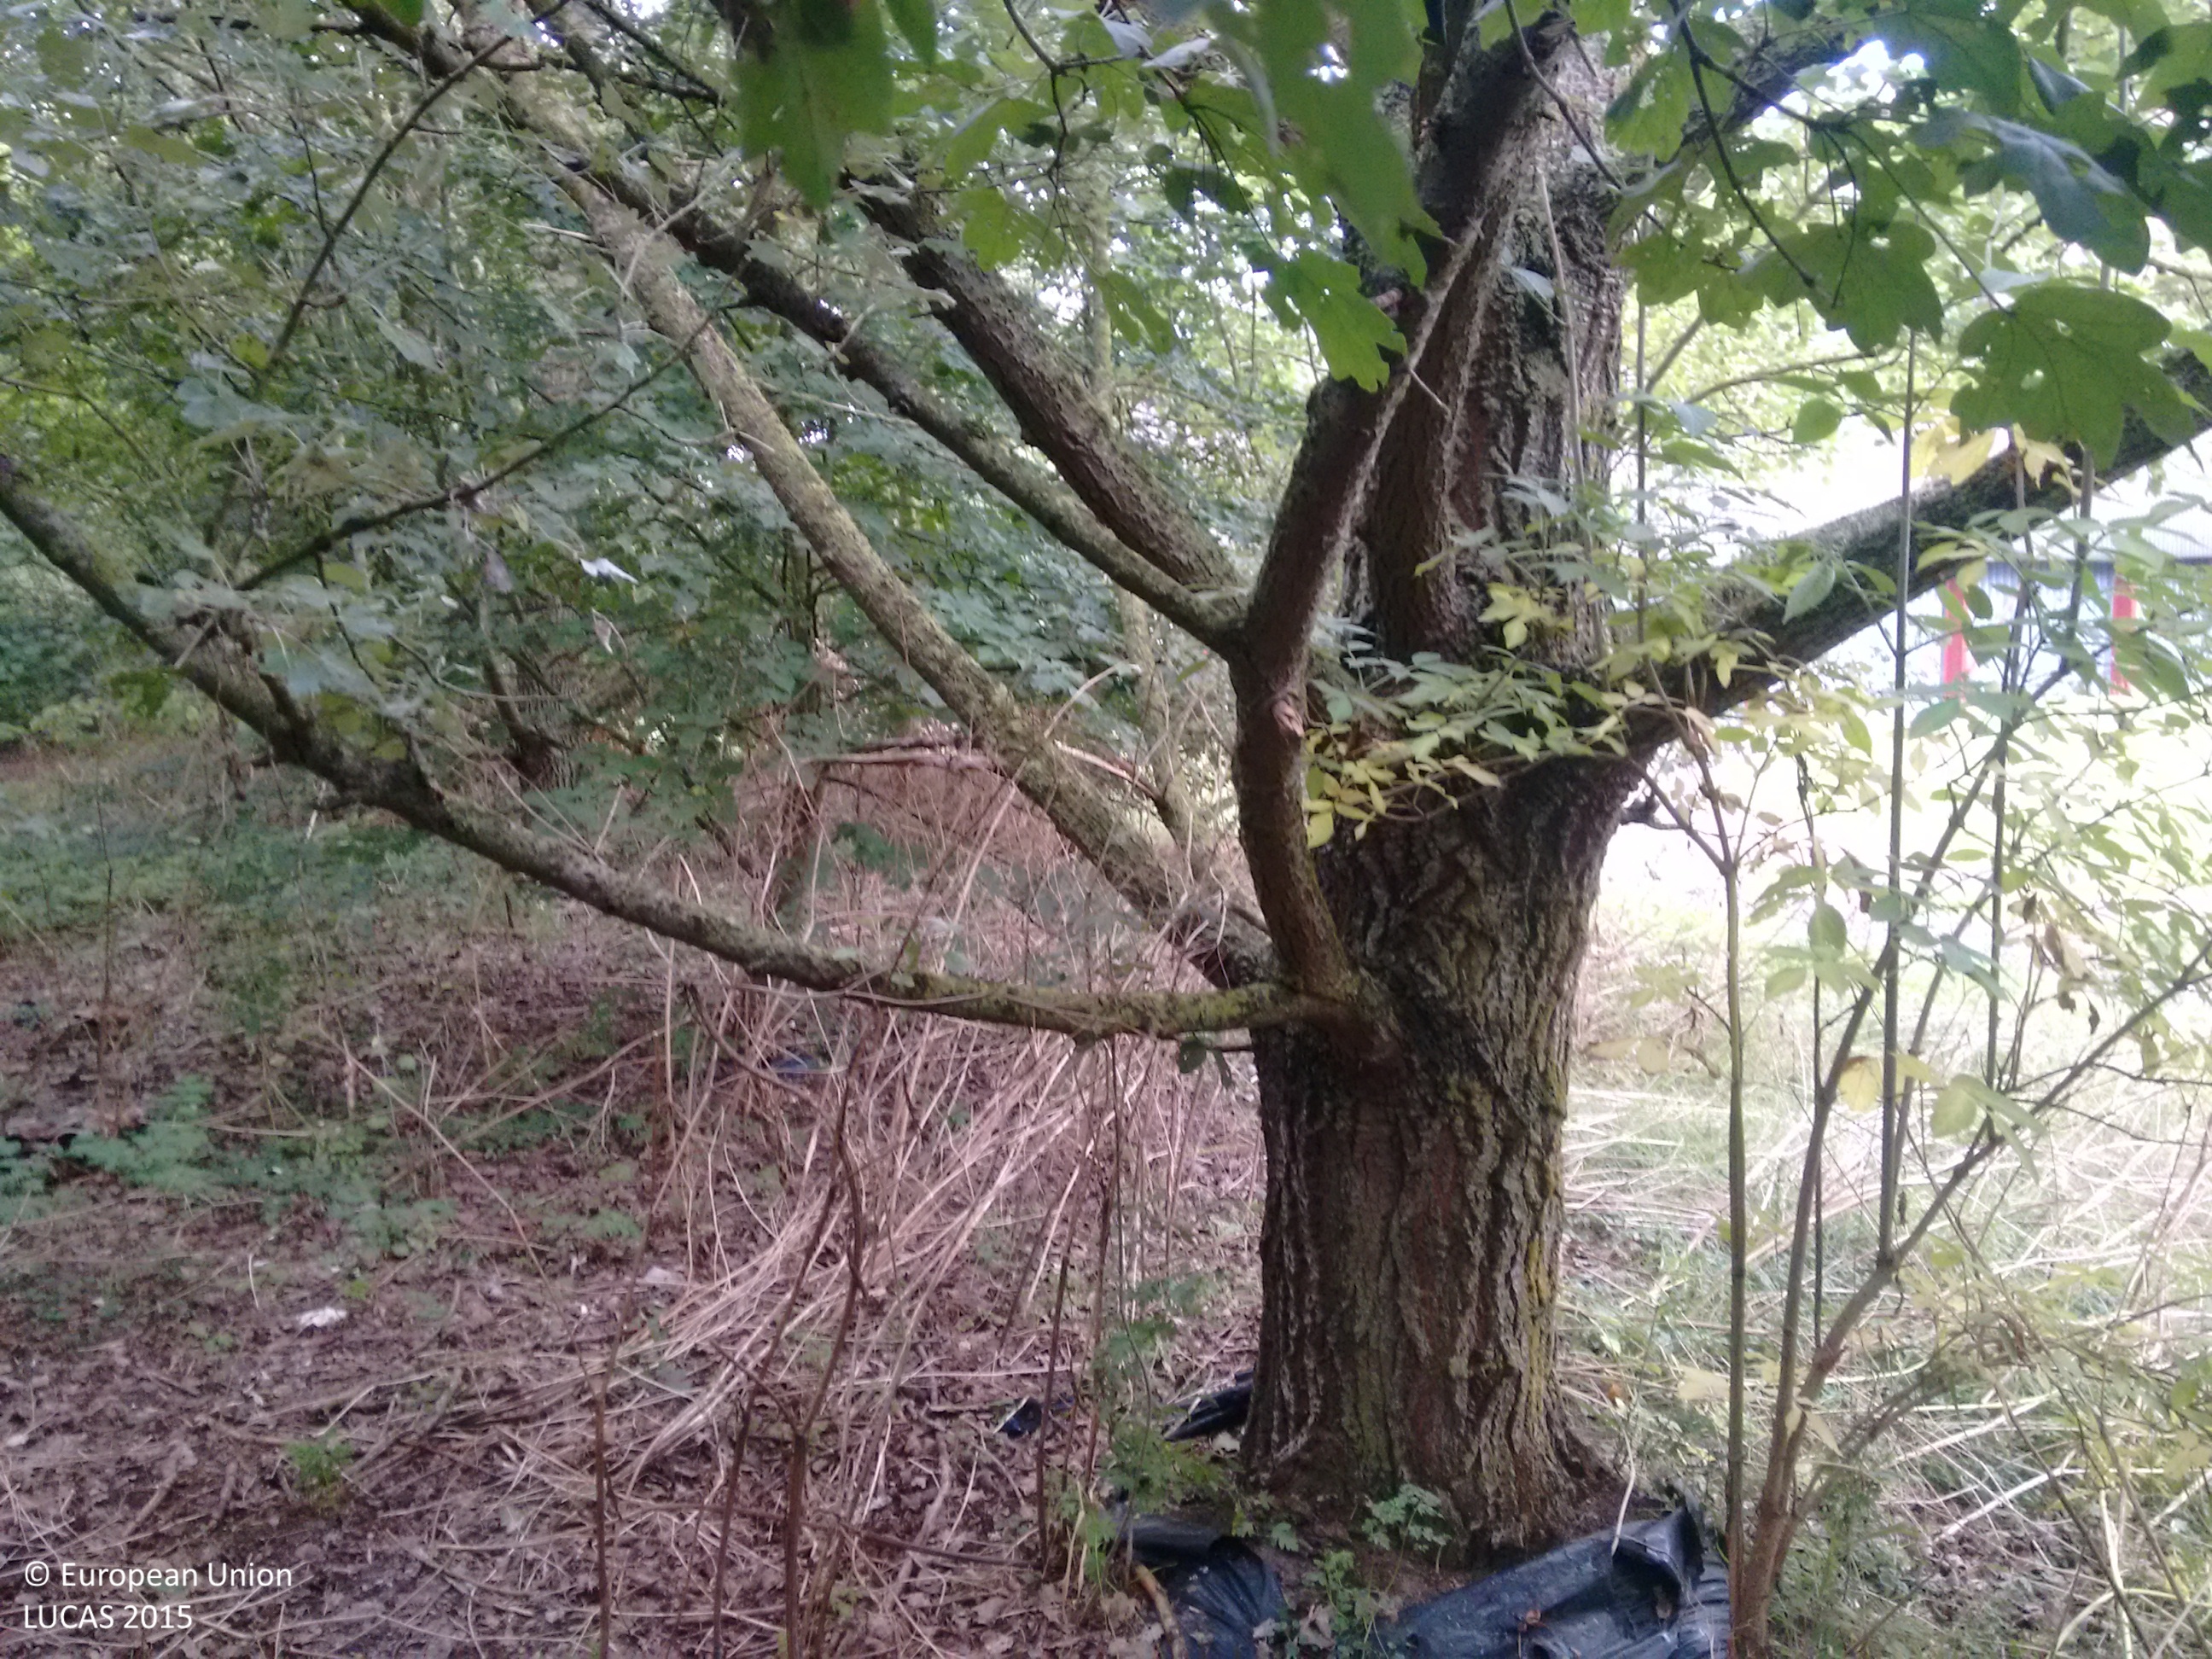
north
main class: Woodland
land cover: Broadleaved woodland
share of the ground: > 75 %
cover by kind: broadleaved forest trees 75 %, shrubs 25 %
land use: Semi-natural and natural areas not in use
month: September
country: GB
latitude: 52.2679
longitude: 0.2842
